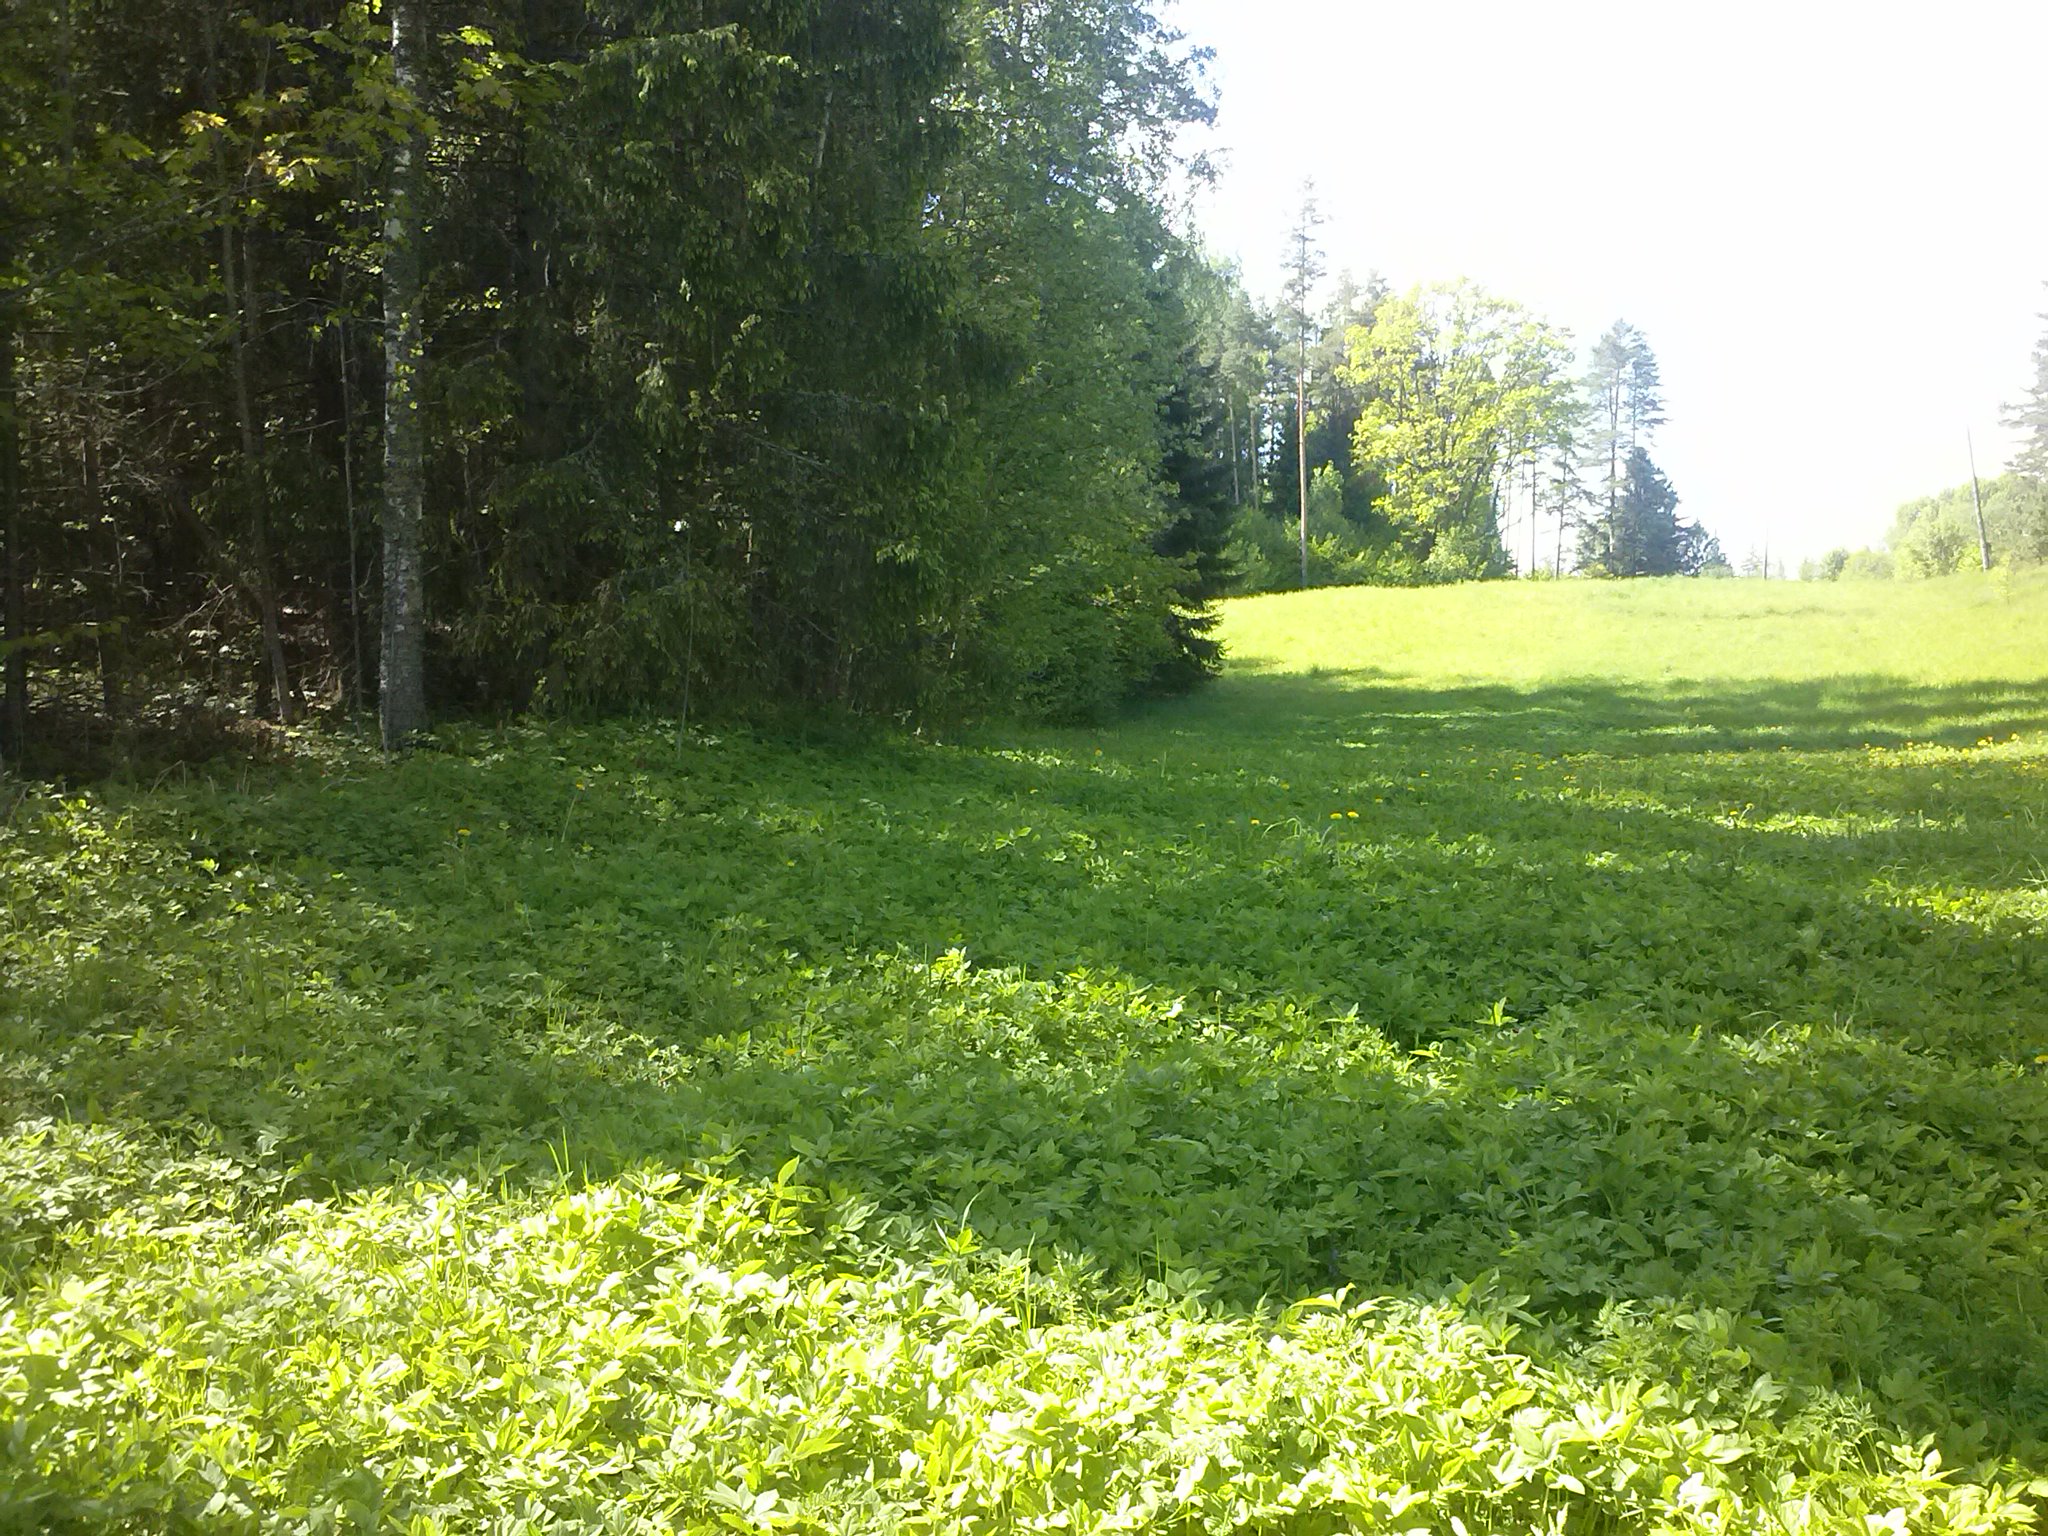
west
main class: Grassland
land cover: Grassland without tree/shrub cover
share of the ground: > 75 %
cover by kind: herbaceous plants 100 %
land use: Agriculture (excluding fallow land and kitchen gardens)
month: May
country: LV
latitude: 56.1882
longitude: 27.5026
